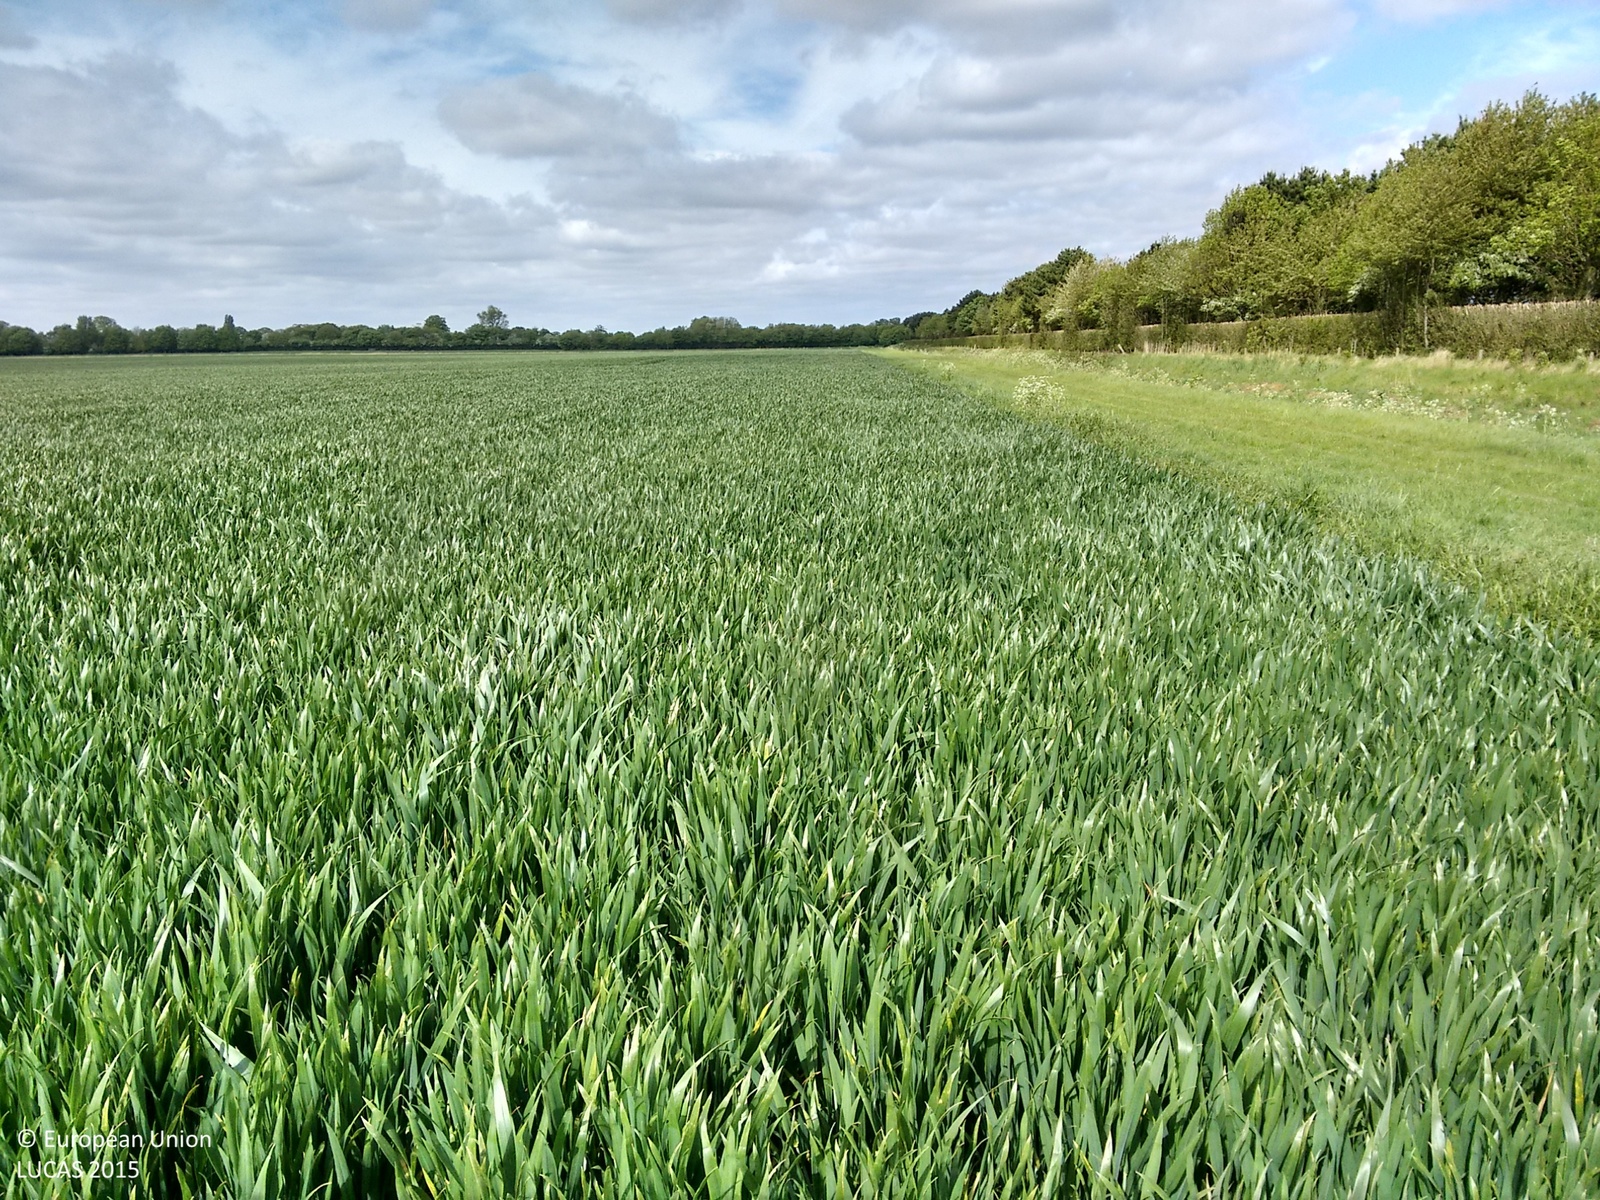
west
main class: Cropland
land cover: Common wheat
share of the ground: > 75 %
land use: Agriculture (excluding fallow land and kitchen gardens)
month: May
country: GB
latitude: 52.8063
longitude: 0.2239
